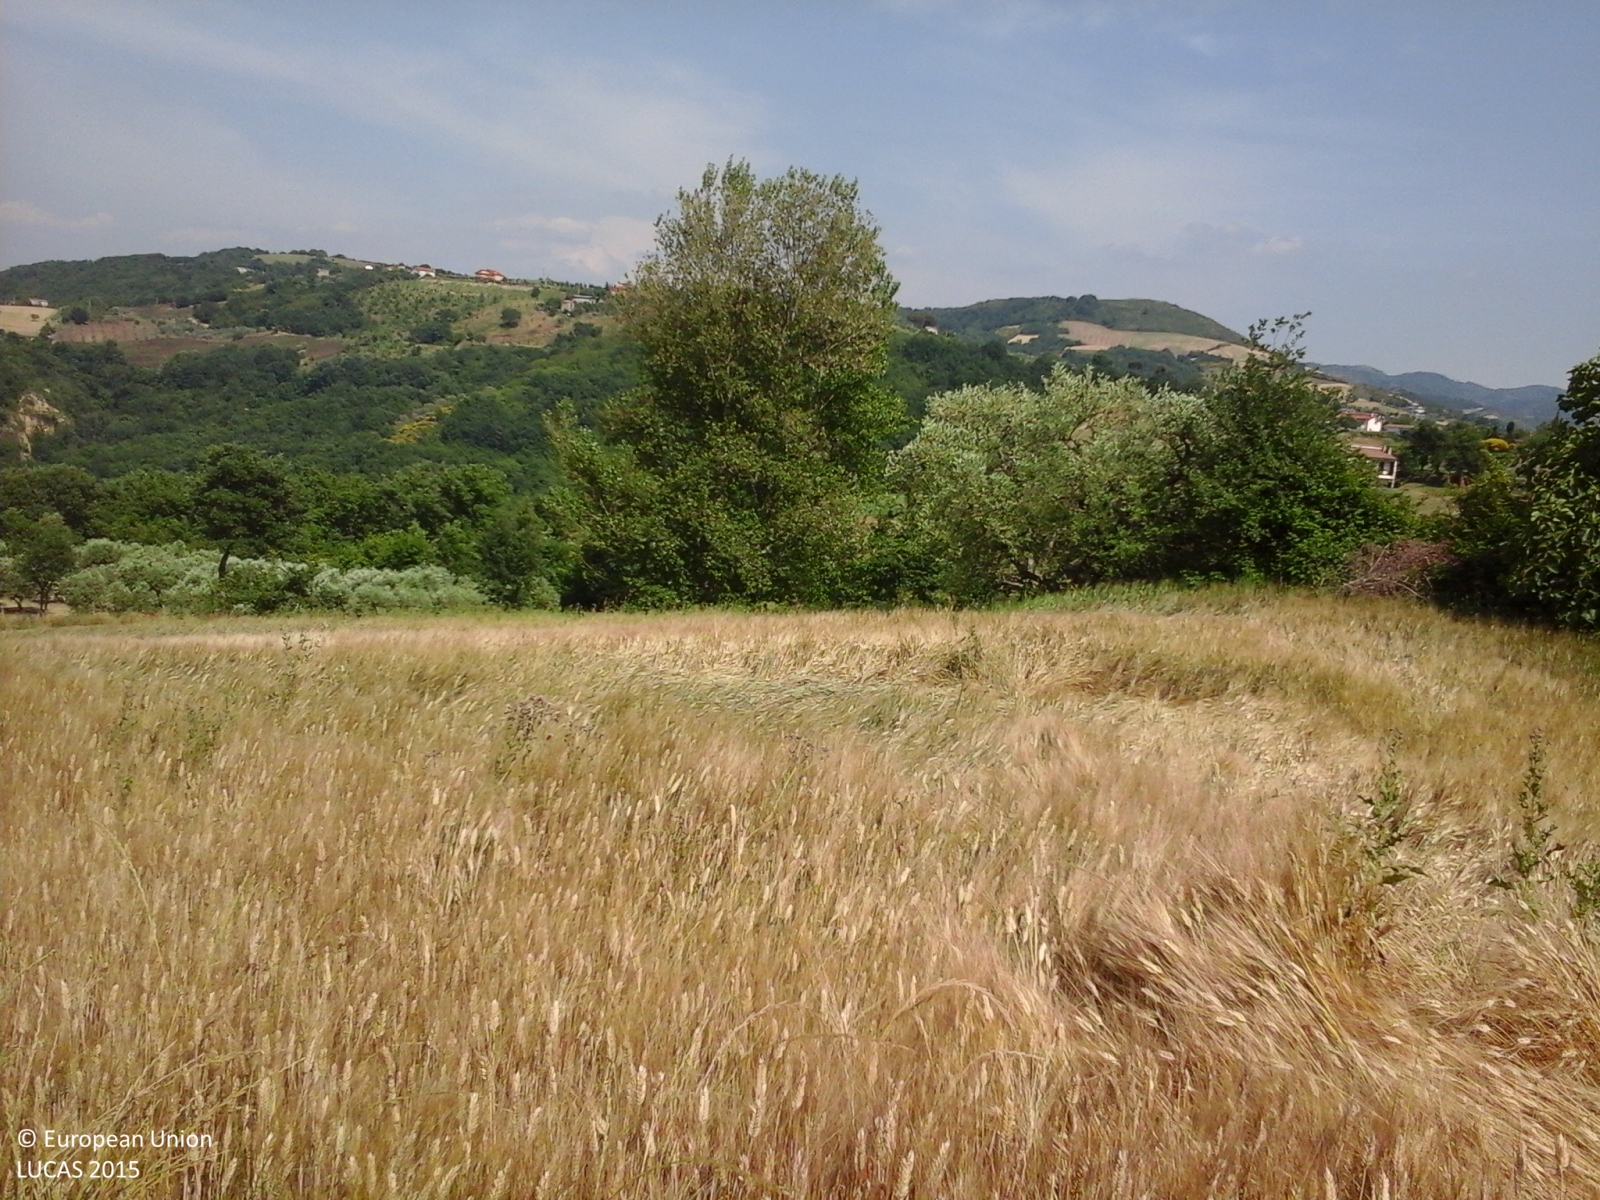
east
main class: Cropland
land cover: Durum wheat
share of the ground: > 75 %
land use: Agriculture (excluding fallow land and kitchen gardens)
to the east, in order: Durum wheat; Grass margins; Other bare soil; Grass margins; Tracks; Grass margins; Other bare soil; Olive groves; Broadleaved woodland; Durum wheat; Ditches and canals; Durum wheat; Grass margins; Tracks; Grass margins; Ditches and canals; Olive groves; Electric lines; Olive groves
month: June
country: IT
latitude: 41.0742
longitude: 15.1581
